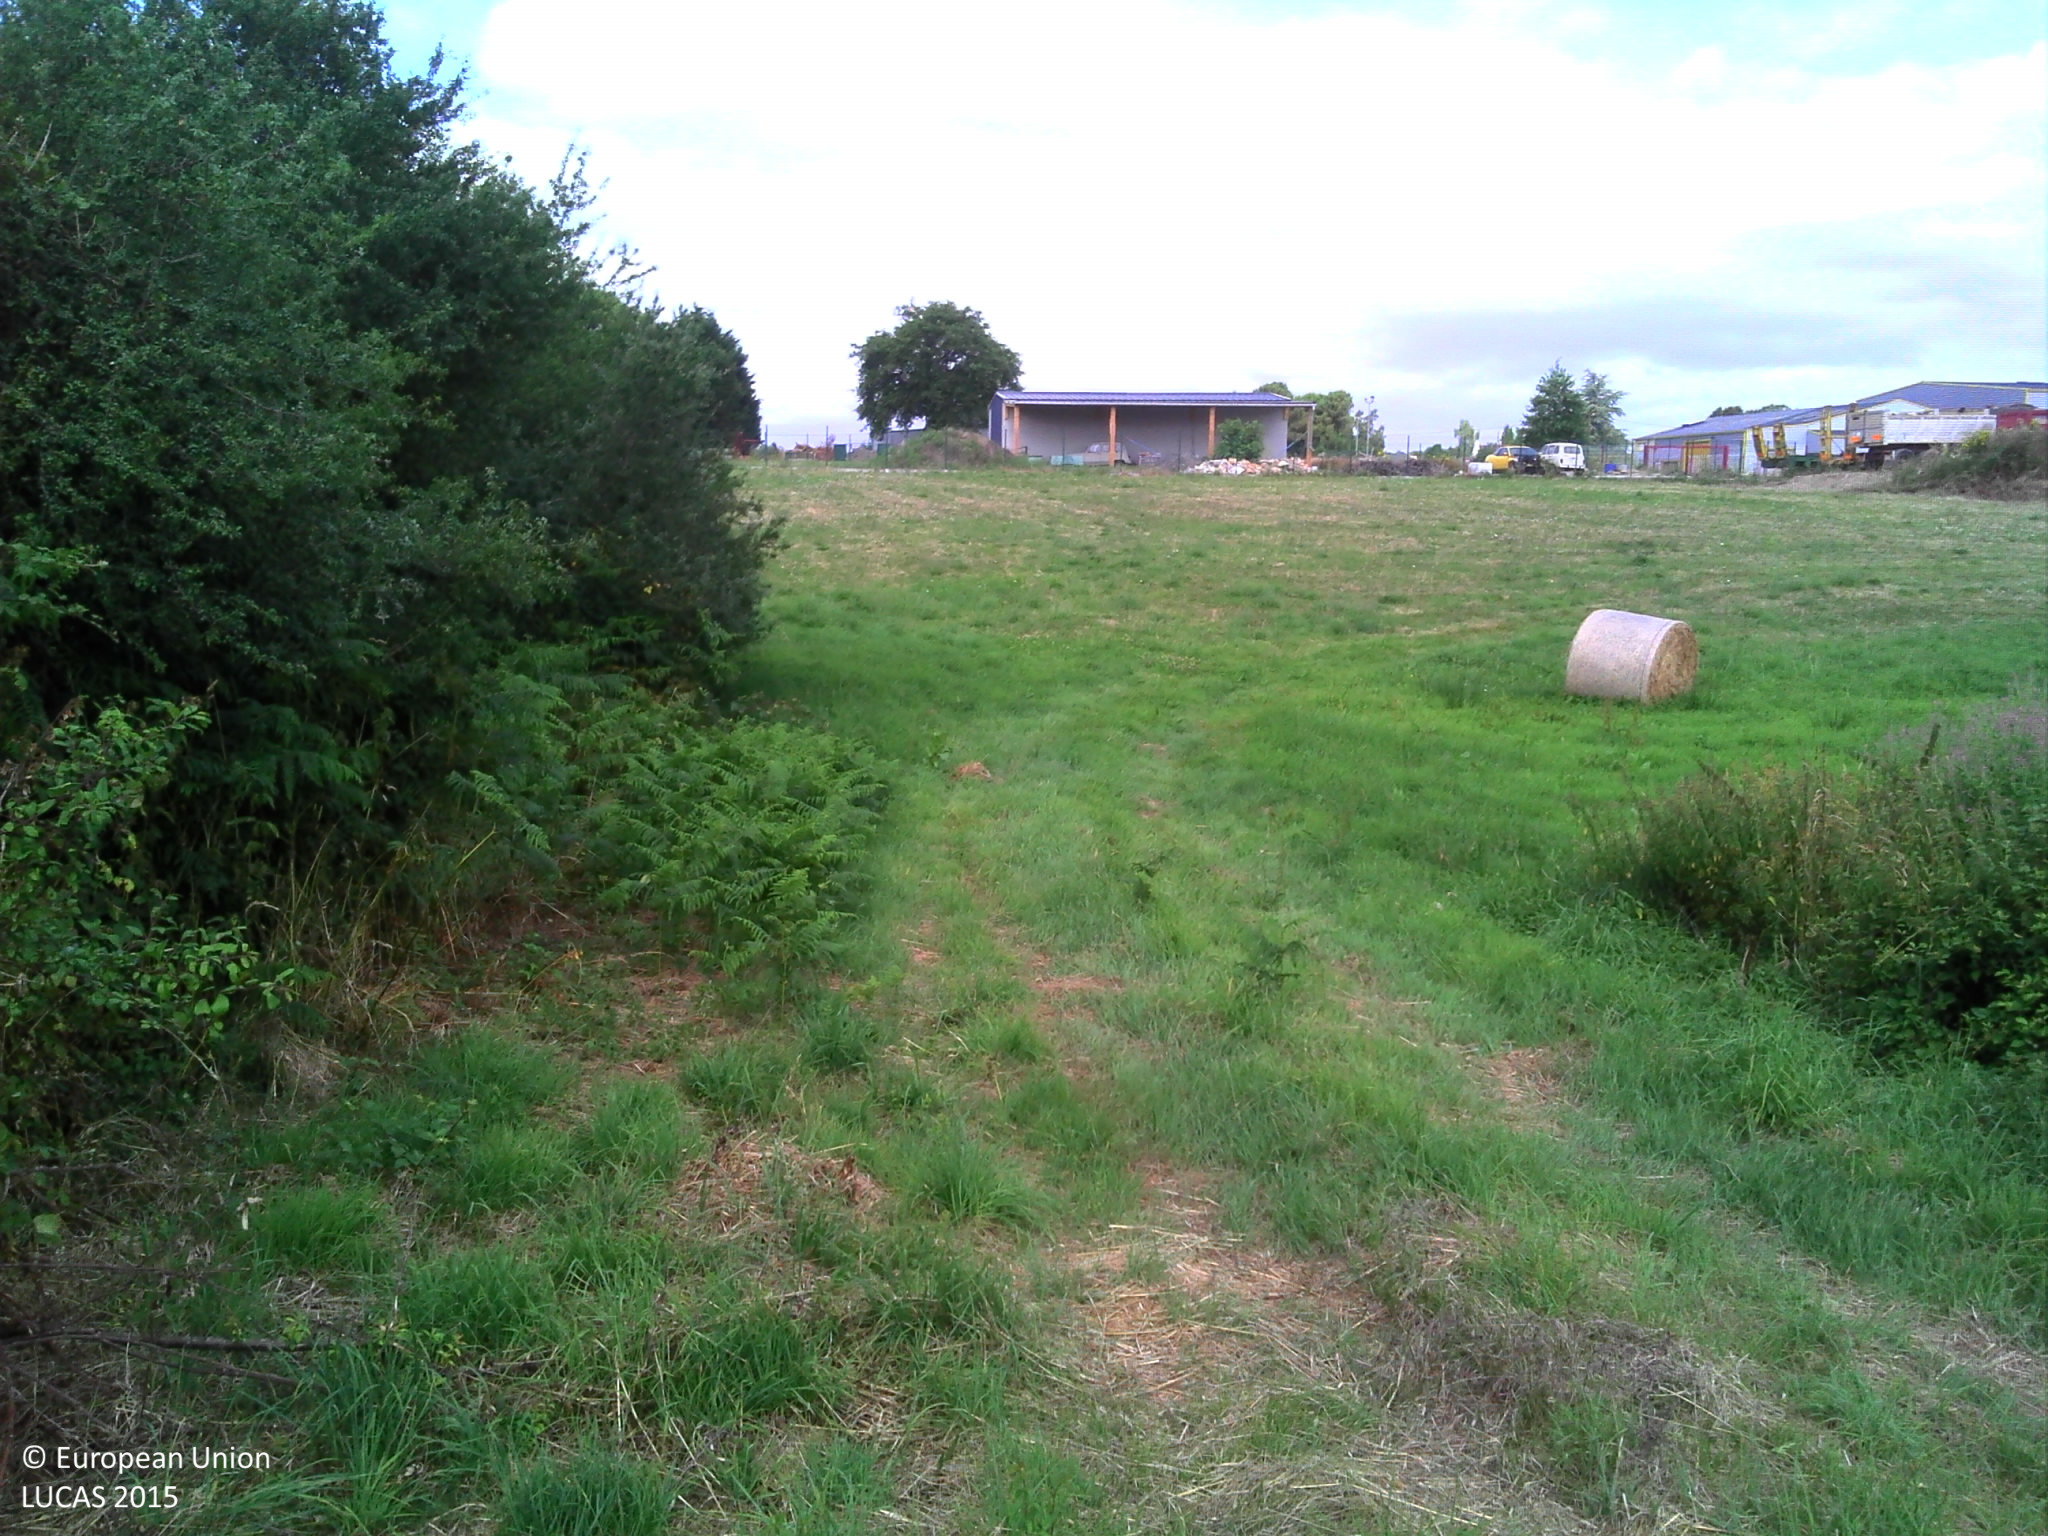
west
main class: Grassland
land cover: Grassland without tree/shrub cover
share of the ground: > 75 %
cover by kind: herbaceous plants 100 %
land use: Agriculture (excluding fallow land and kitchen gardens)
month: July
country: FR
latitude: 47.5596
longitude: -2.0517
